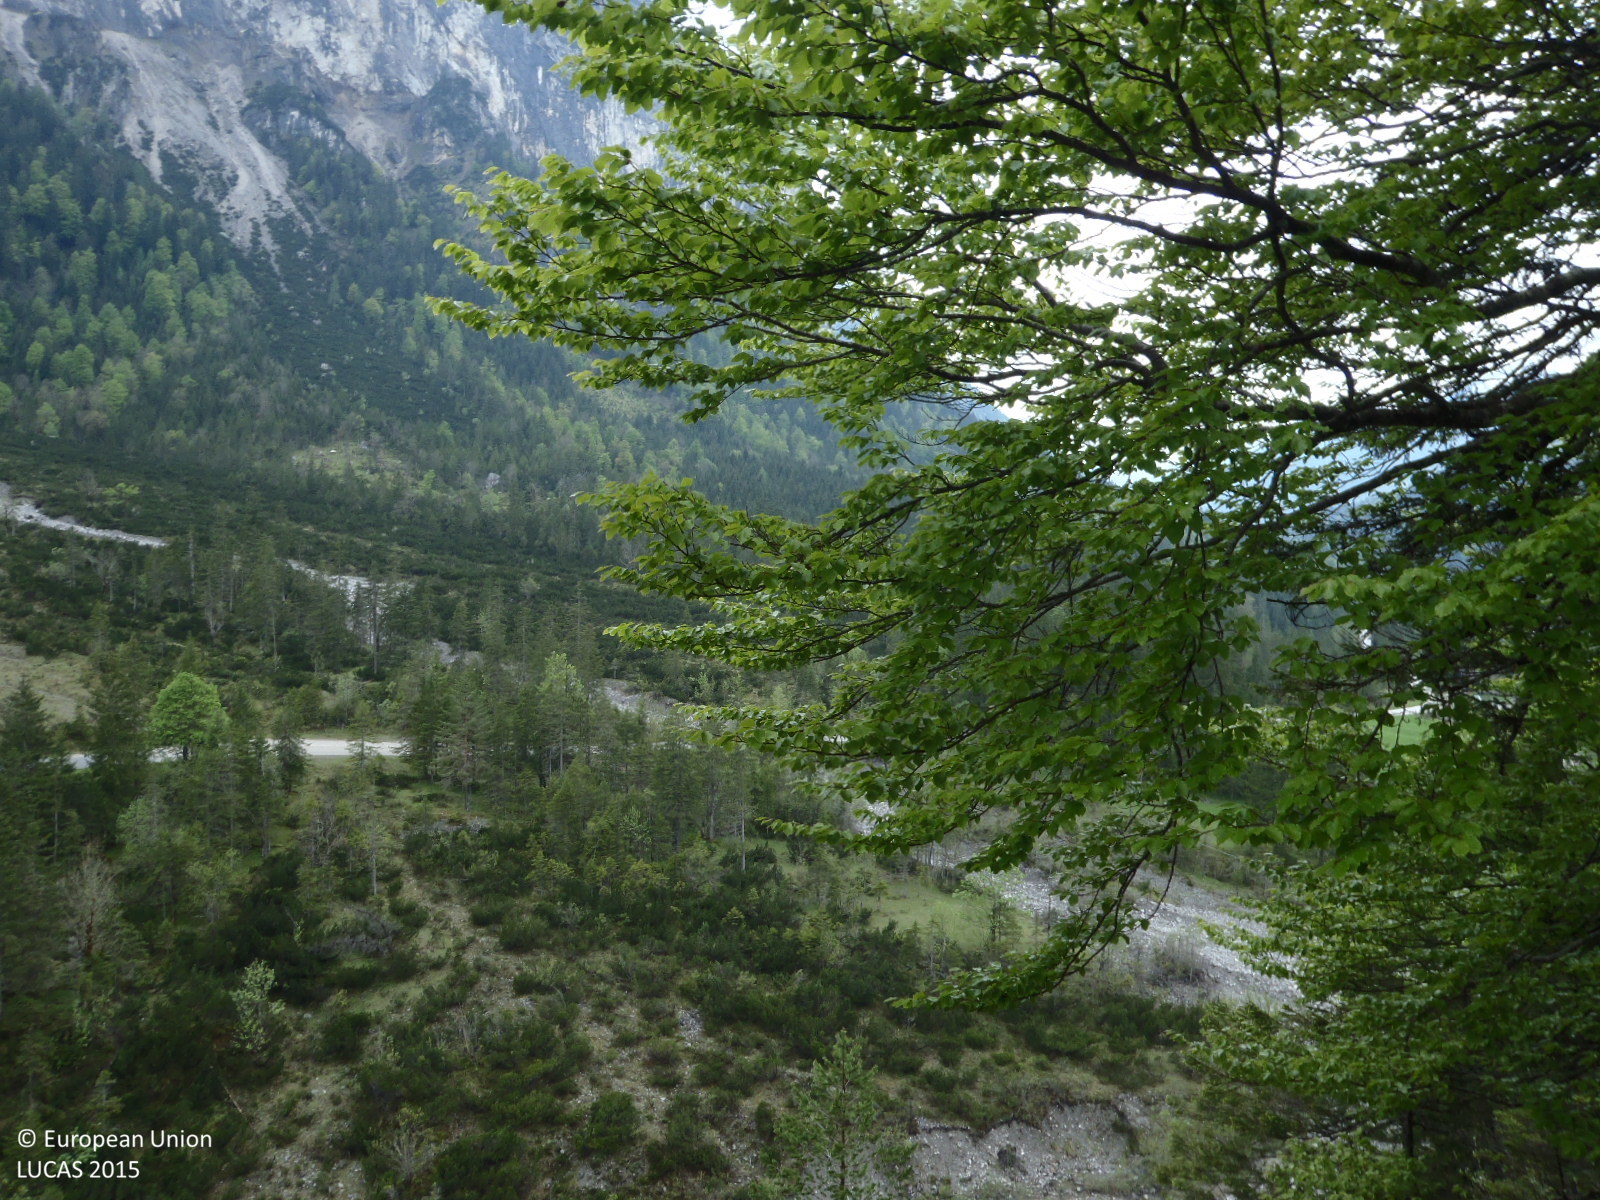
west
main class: Grassland
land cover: Grassland with sparse tree/shrub cover
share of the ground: > 75 %
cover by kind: herbaceous plants 55 %, unconsolidated bare surface 35 %, coniferous forest trees 5 %, shrubs 5 %
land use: Semi-natural and natural areas not in use
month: May
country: AT
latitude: 47.4382
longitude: 11.5766
